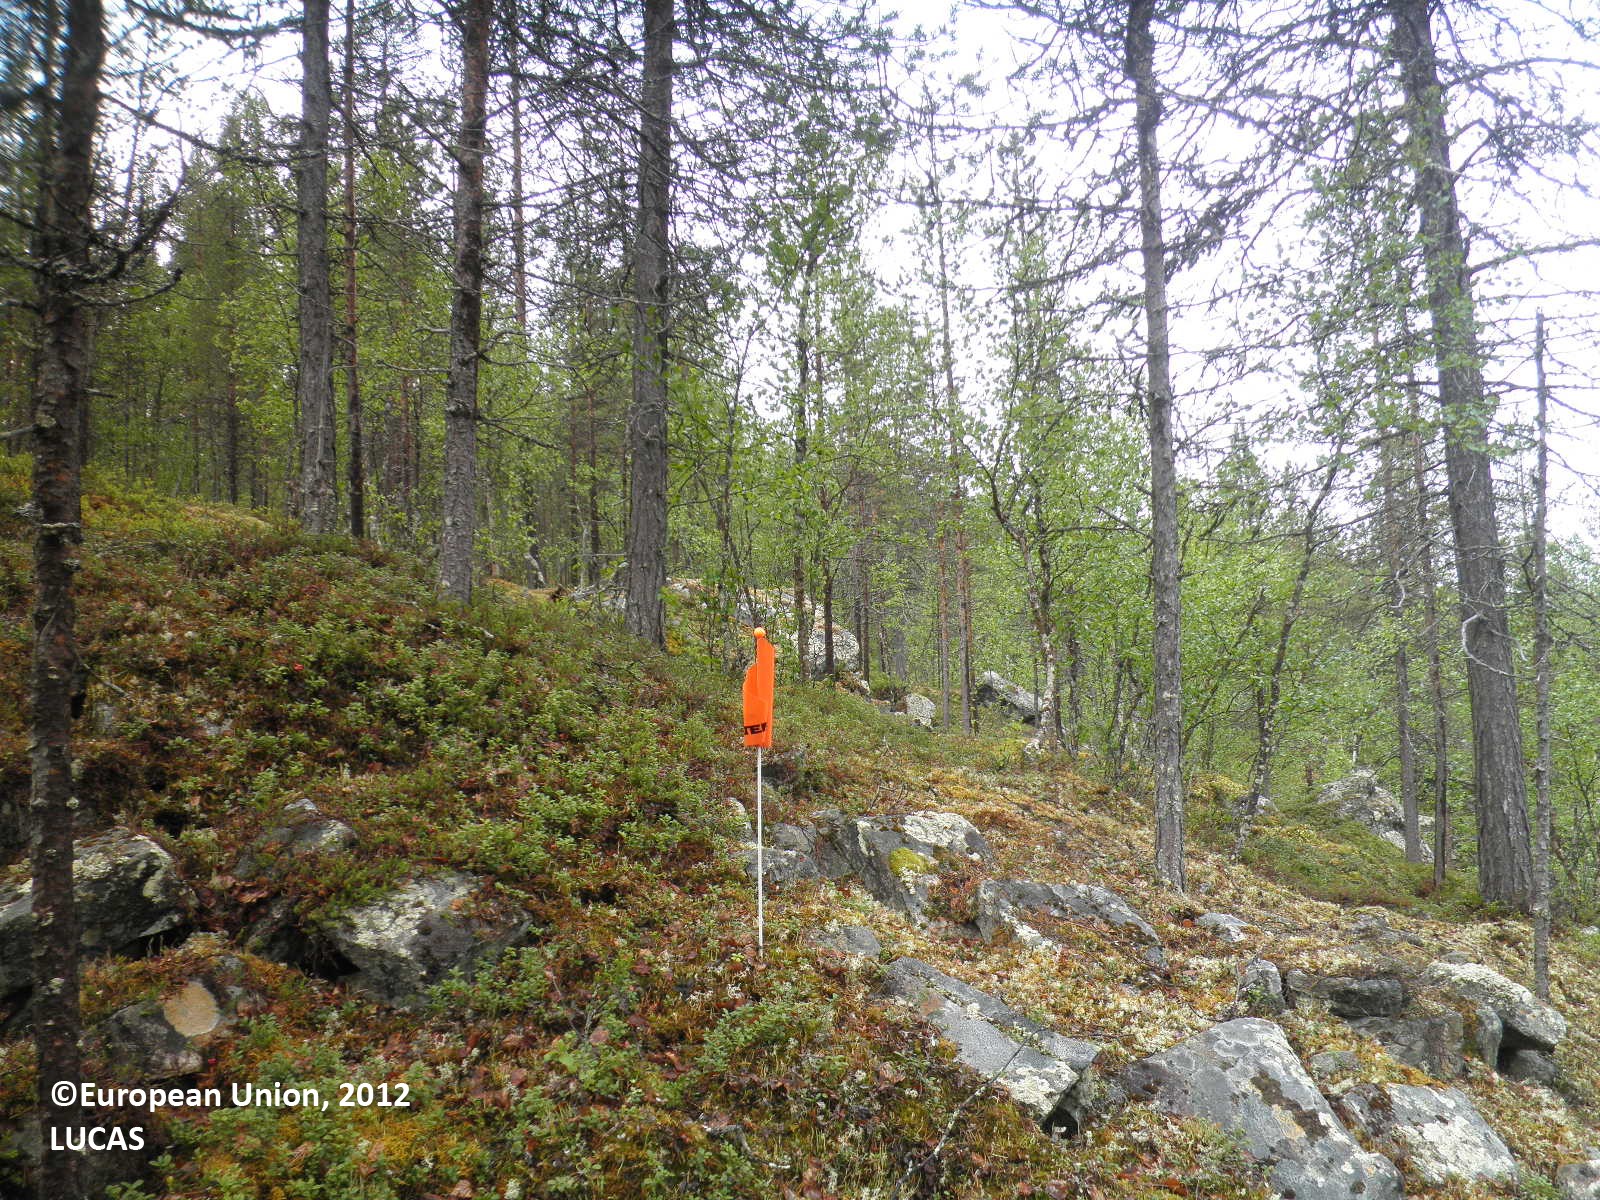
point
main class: Woodland
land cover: Pine dominated mixed woodland
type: boreal forest
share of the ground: 50 - 75 %
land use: Forestry
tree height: > 5 m
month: June
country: FI
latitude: 68.4034
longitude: 26.4391
